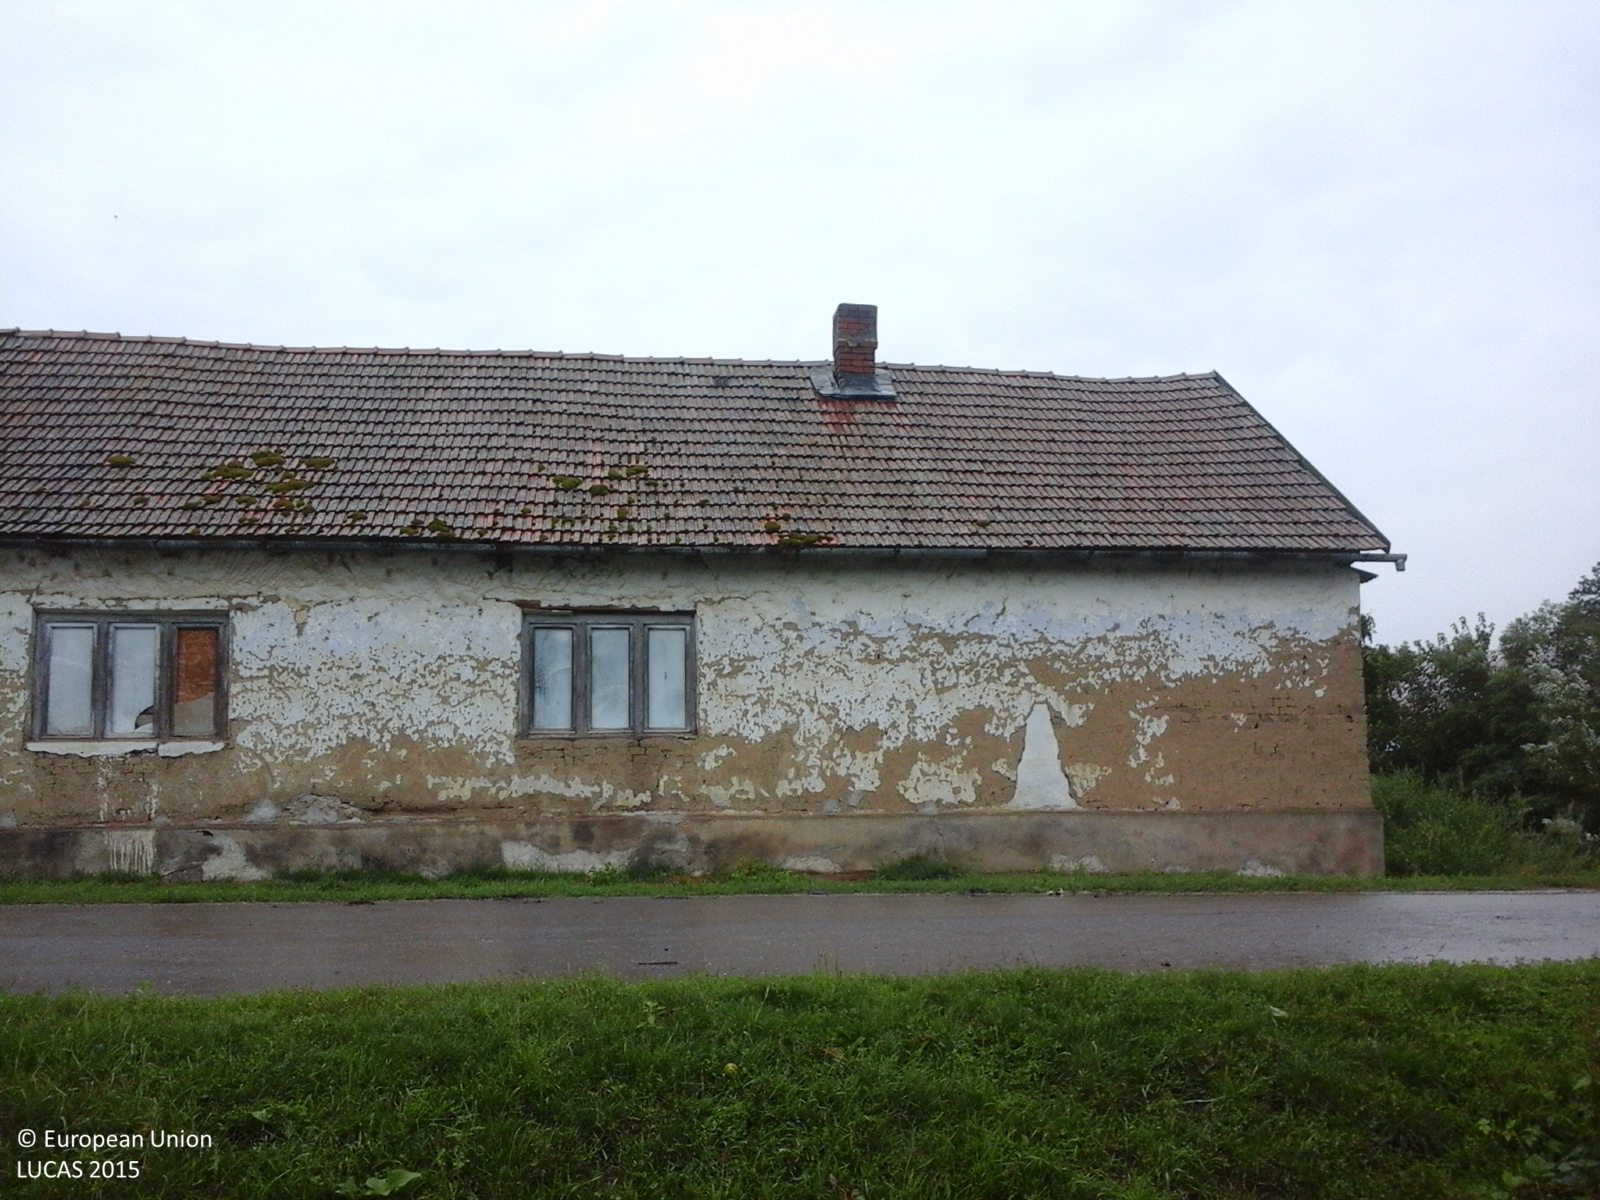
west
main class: Grassland
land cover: Grassland without tree/shrub cover
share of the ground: > 75 %
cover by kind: herbaceous plants 100 %
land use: Residential
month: September
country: RO
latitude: 47.3172
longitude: 22.4244
